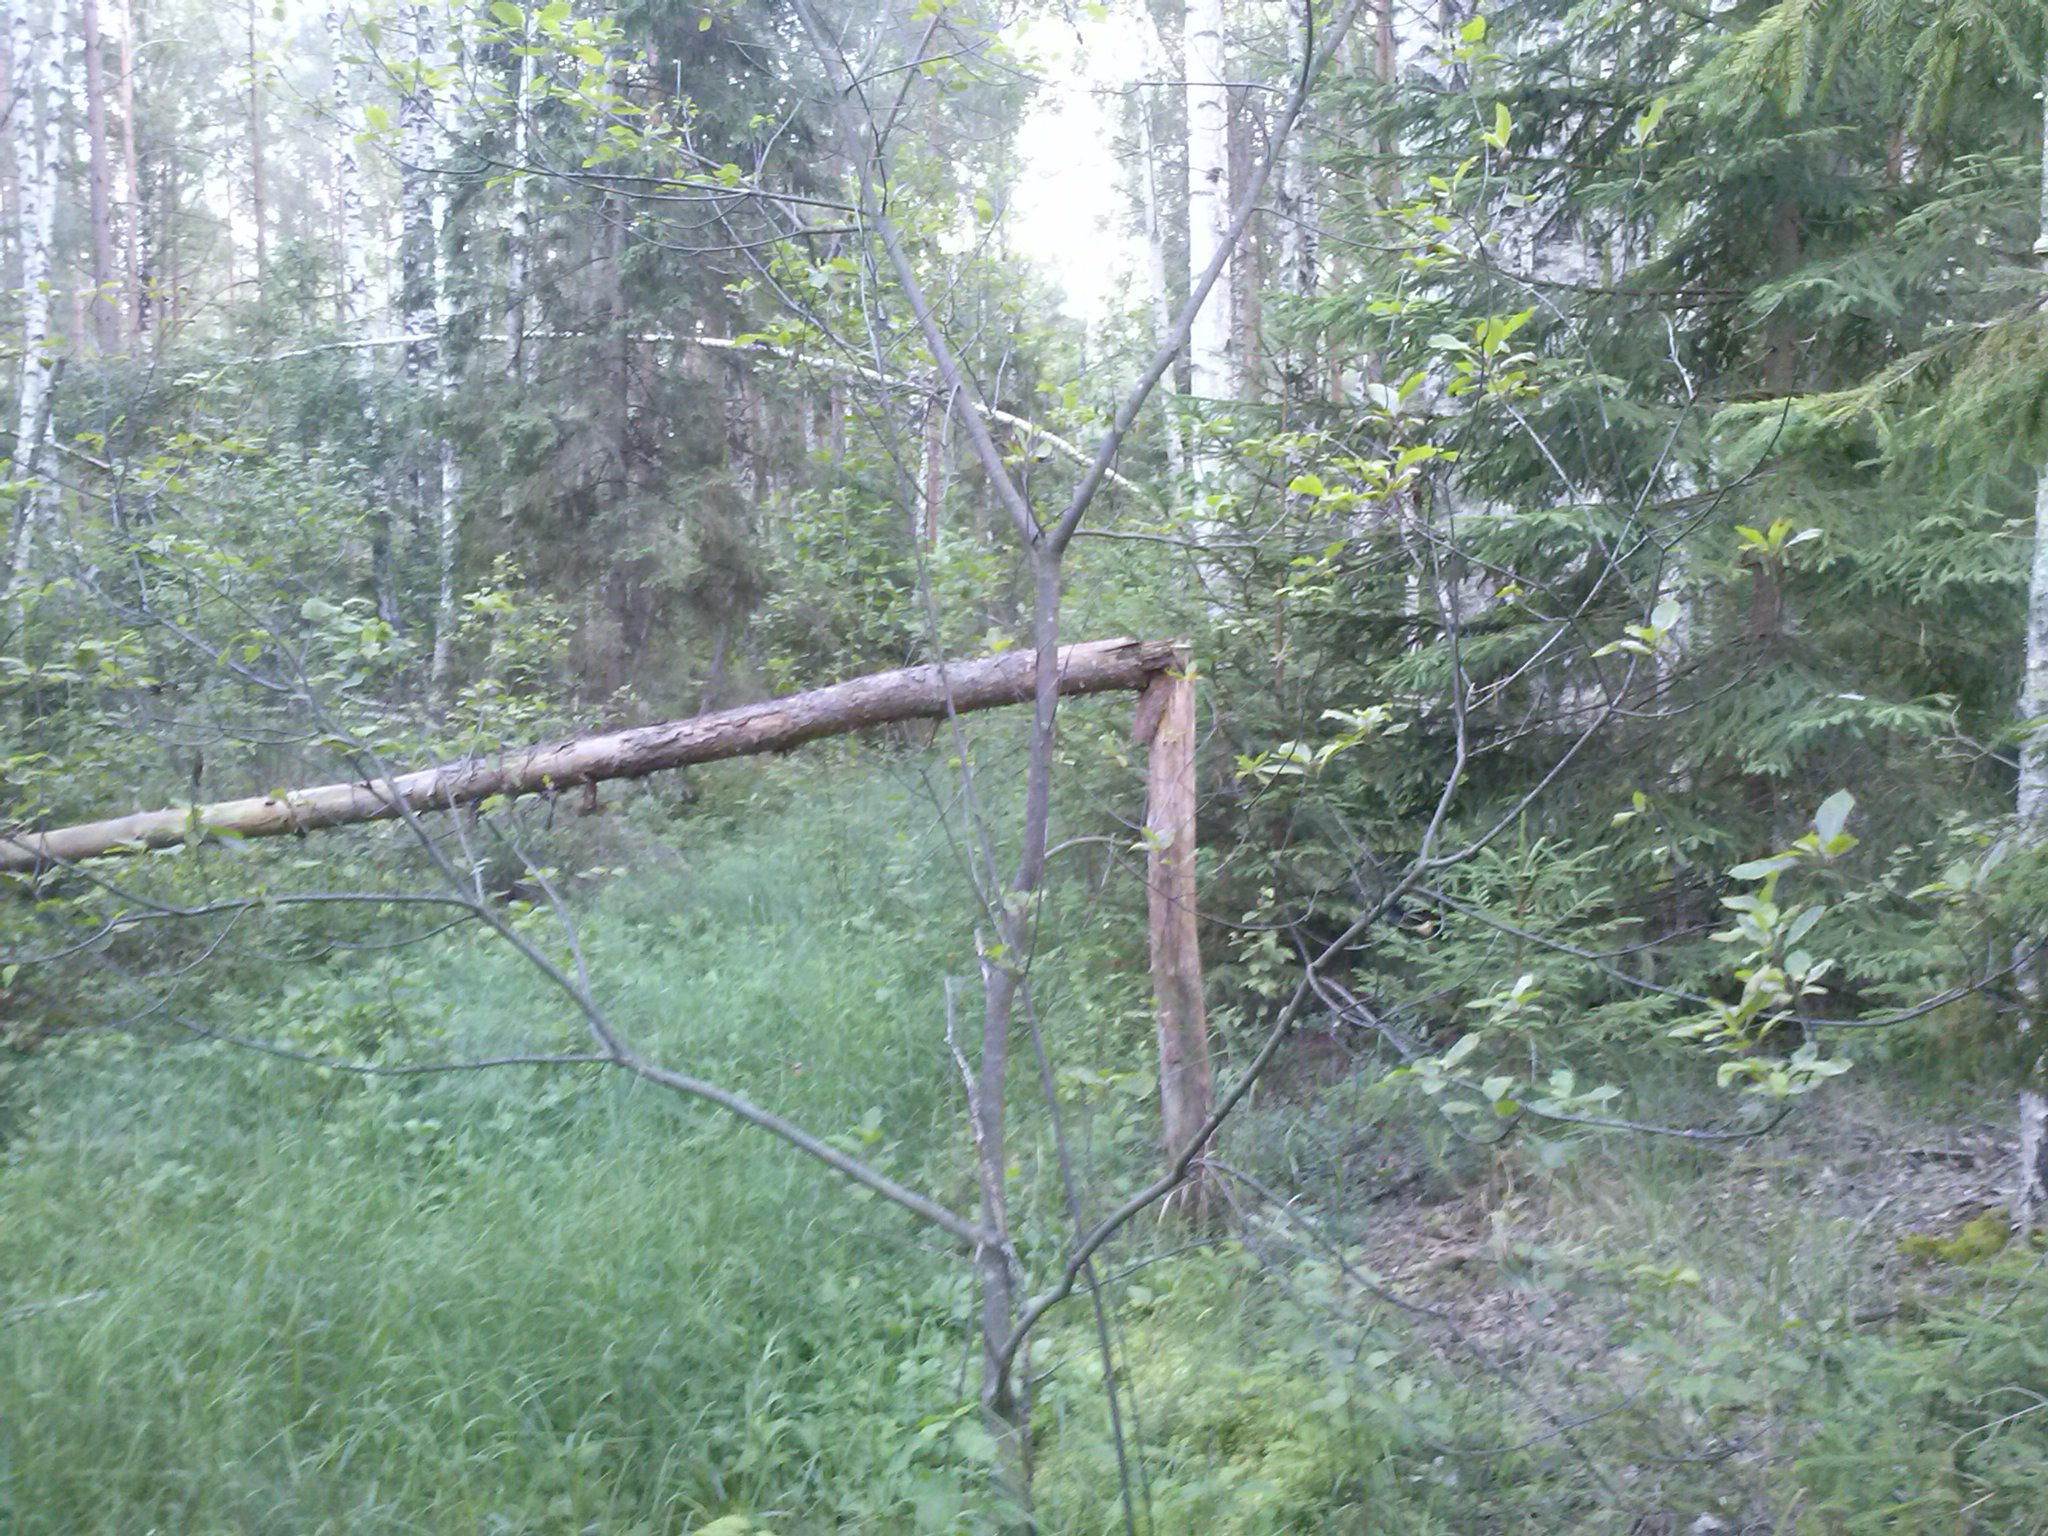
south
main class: Woodland
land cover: Spruce dominated mixed woodland
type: hemiboreal forest and nemoral coniferous forest and mixed broadleaved-coniferous forest
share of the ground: > 75 %
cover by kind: coniferous forest trees 50 %, broadleaved forest trees 30 %, herbaceous plants 20 %
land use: Forestry
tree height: > 5 m
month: July
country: LV
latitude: 56.8126
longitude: 27.7967
